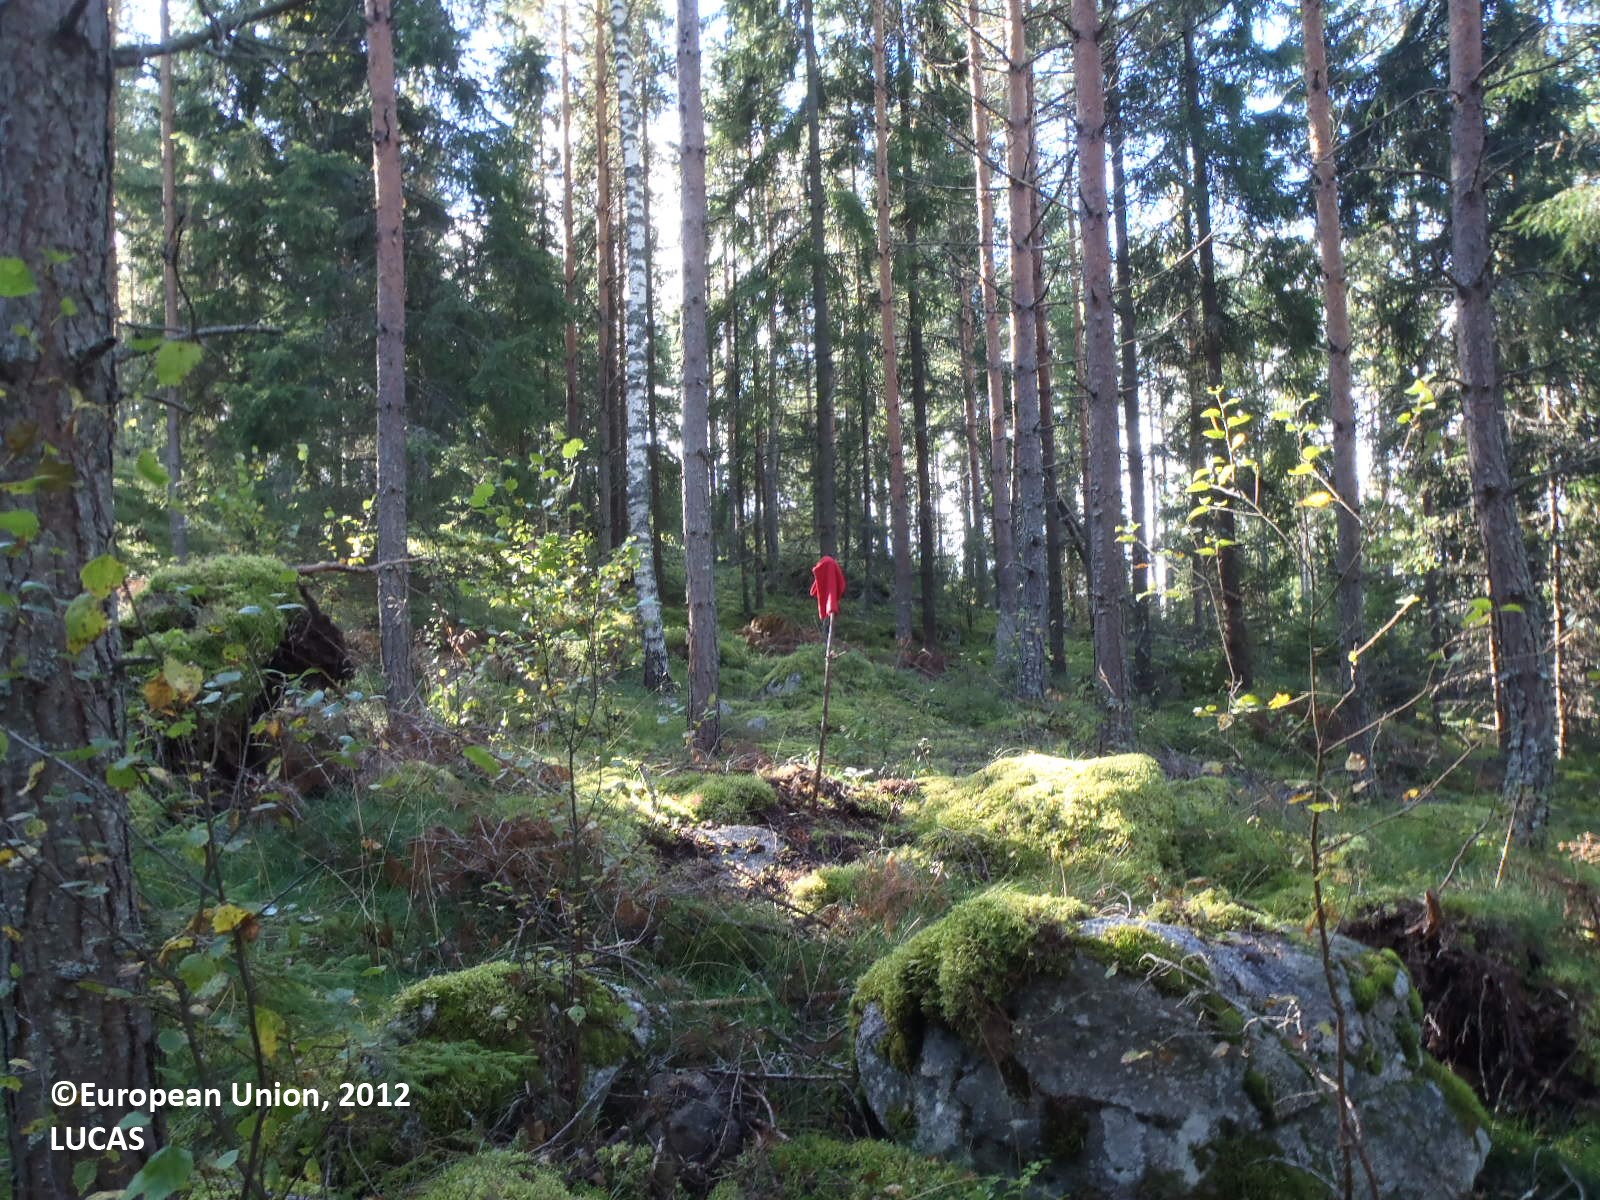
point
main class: Woodland
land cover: Pine dominated coniferous woodland
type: boreal forest
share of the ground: 50 - 75 %
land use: Forestry
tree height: > 5 m
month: September
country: FI
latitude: 61.2964
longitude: 22.7799
